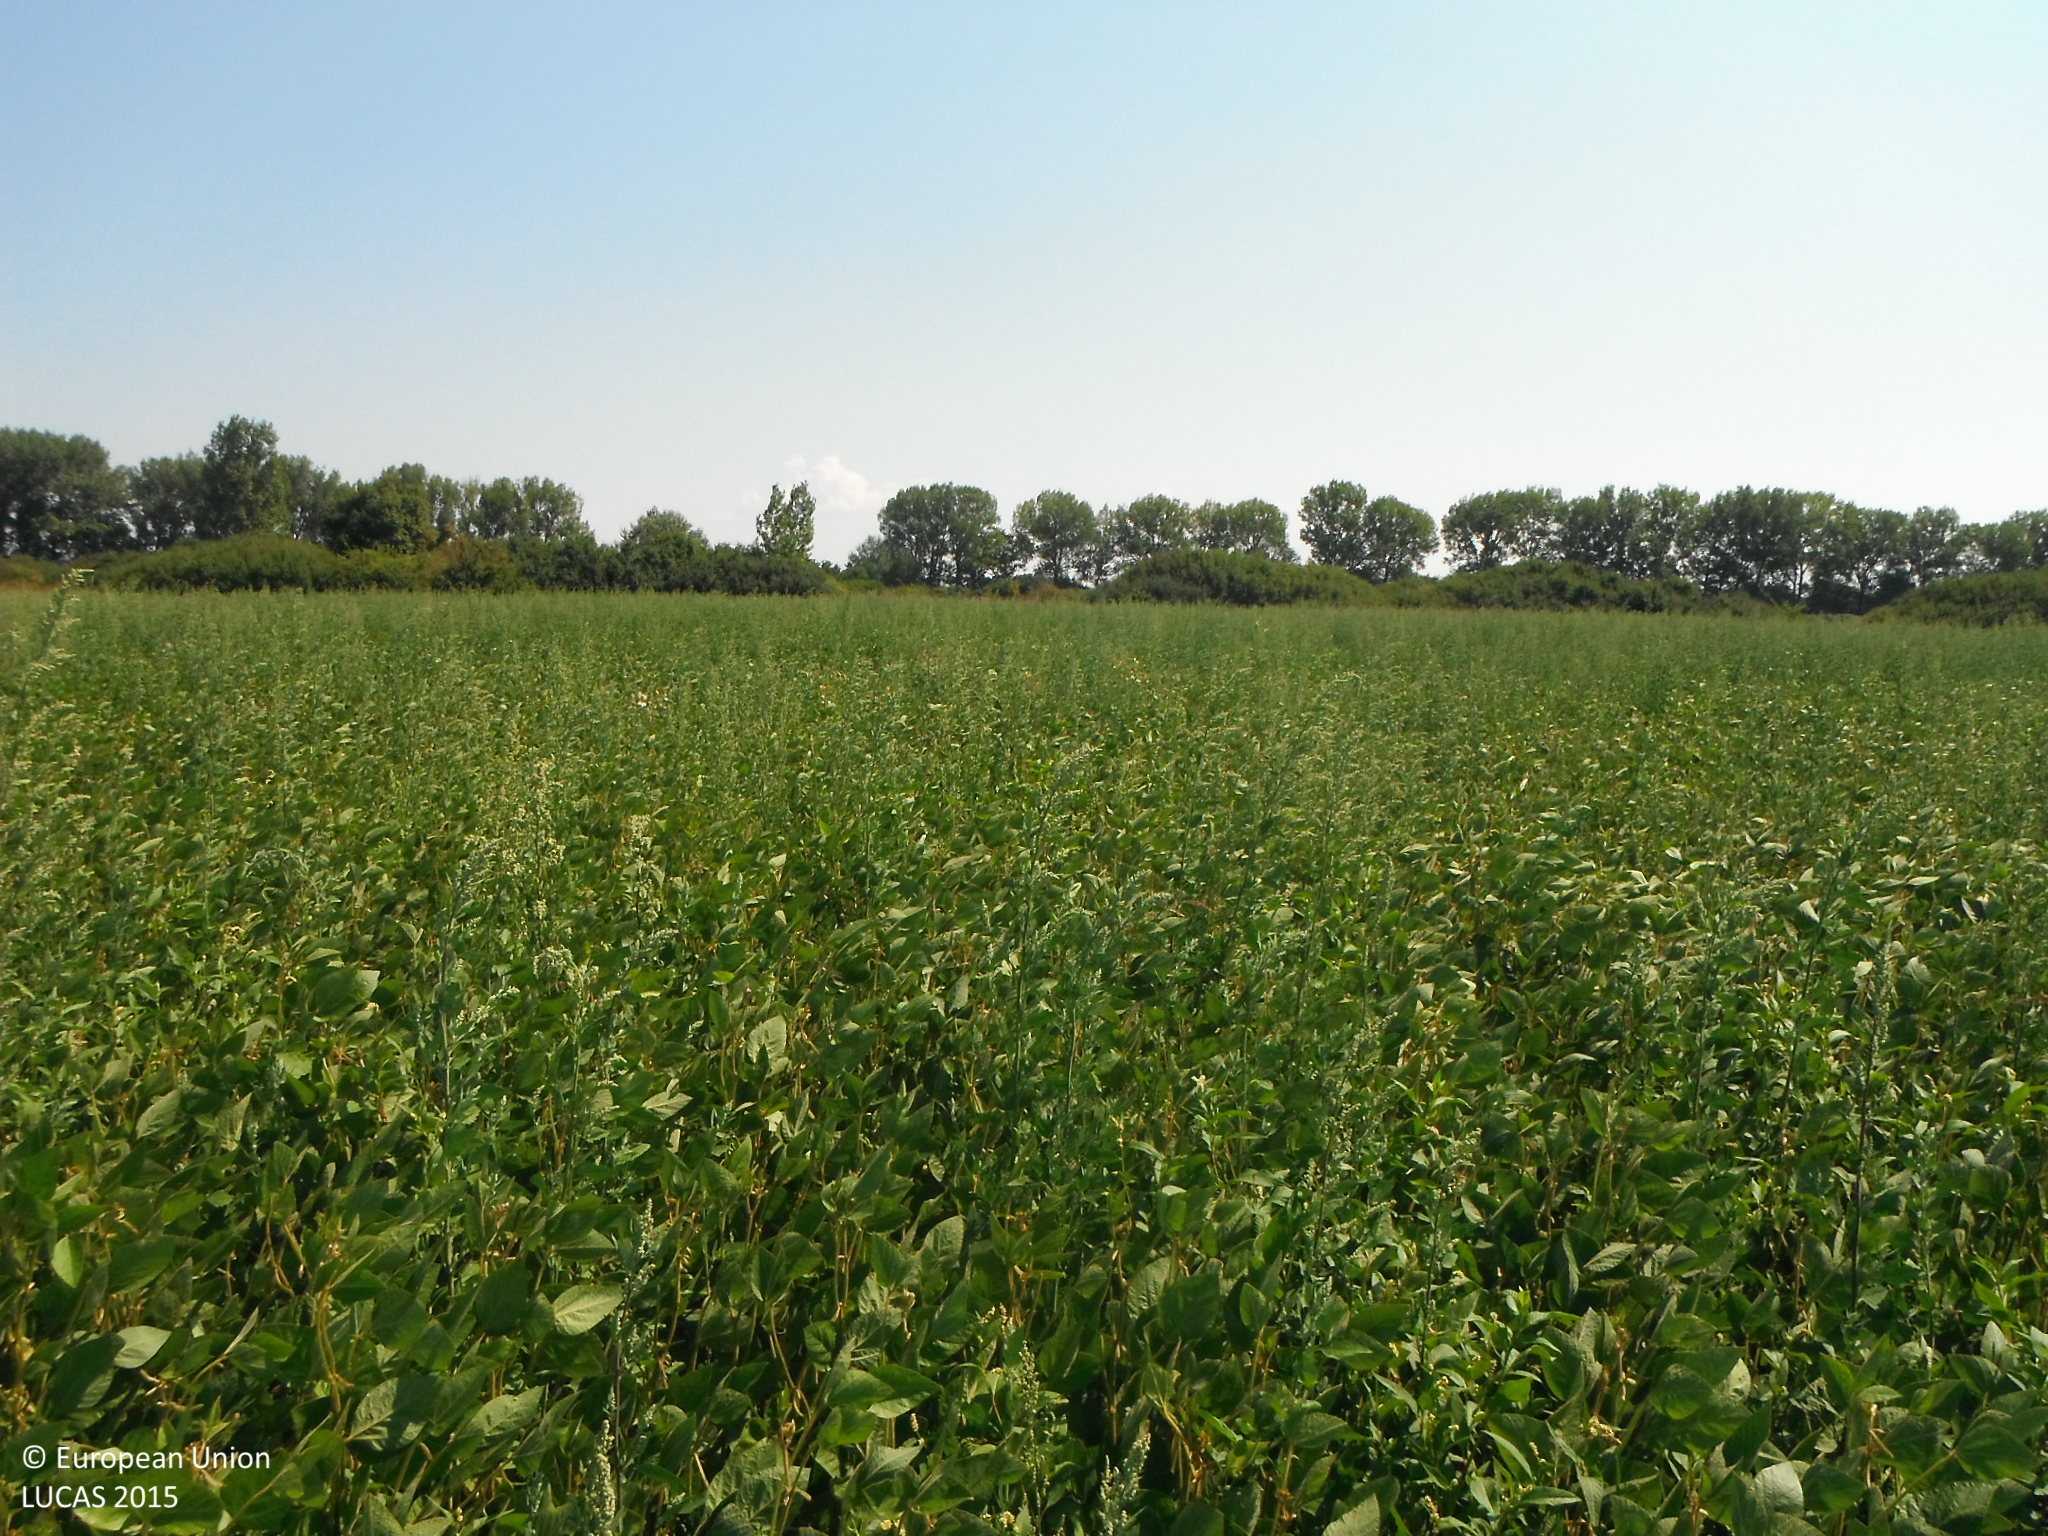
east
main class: Cropland
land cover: Soya
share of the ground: > 75 %
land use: Agriculture (excluding fallow land and kitchen gardens)
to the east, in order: Soya; Shrubland without tree cover; Ditches and canals; Shrubland without tree cover; Soya
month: August
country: SK
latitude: 48.6844
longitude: 21.9114
